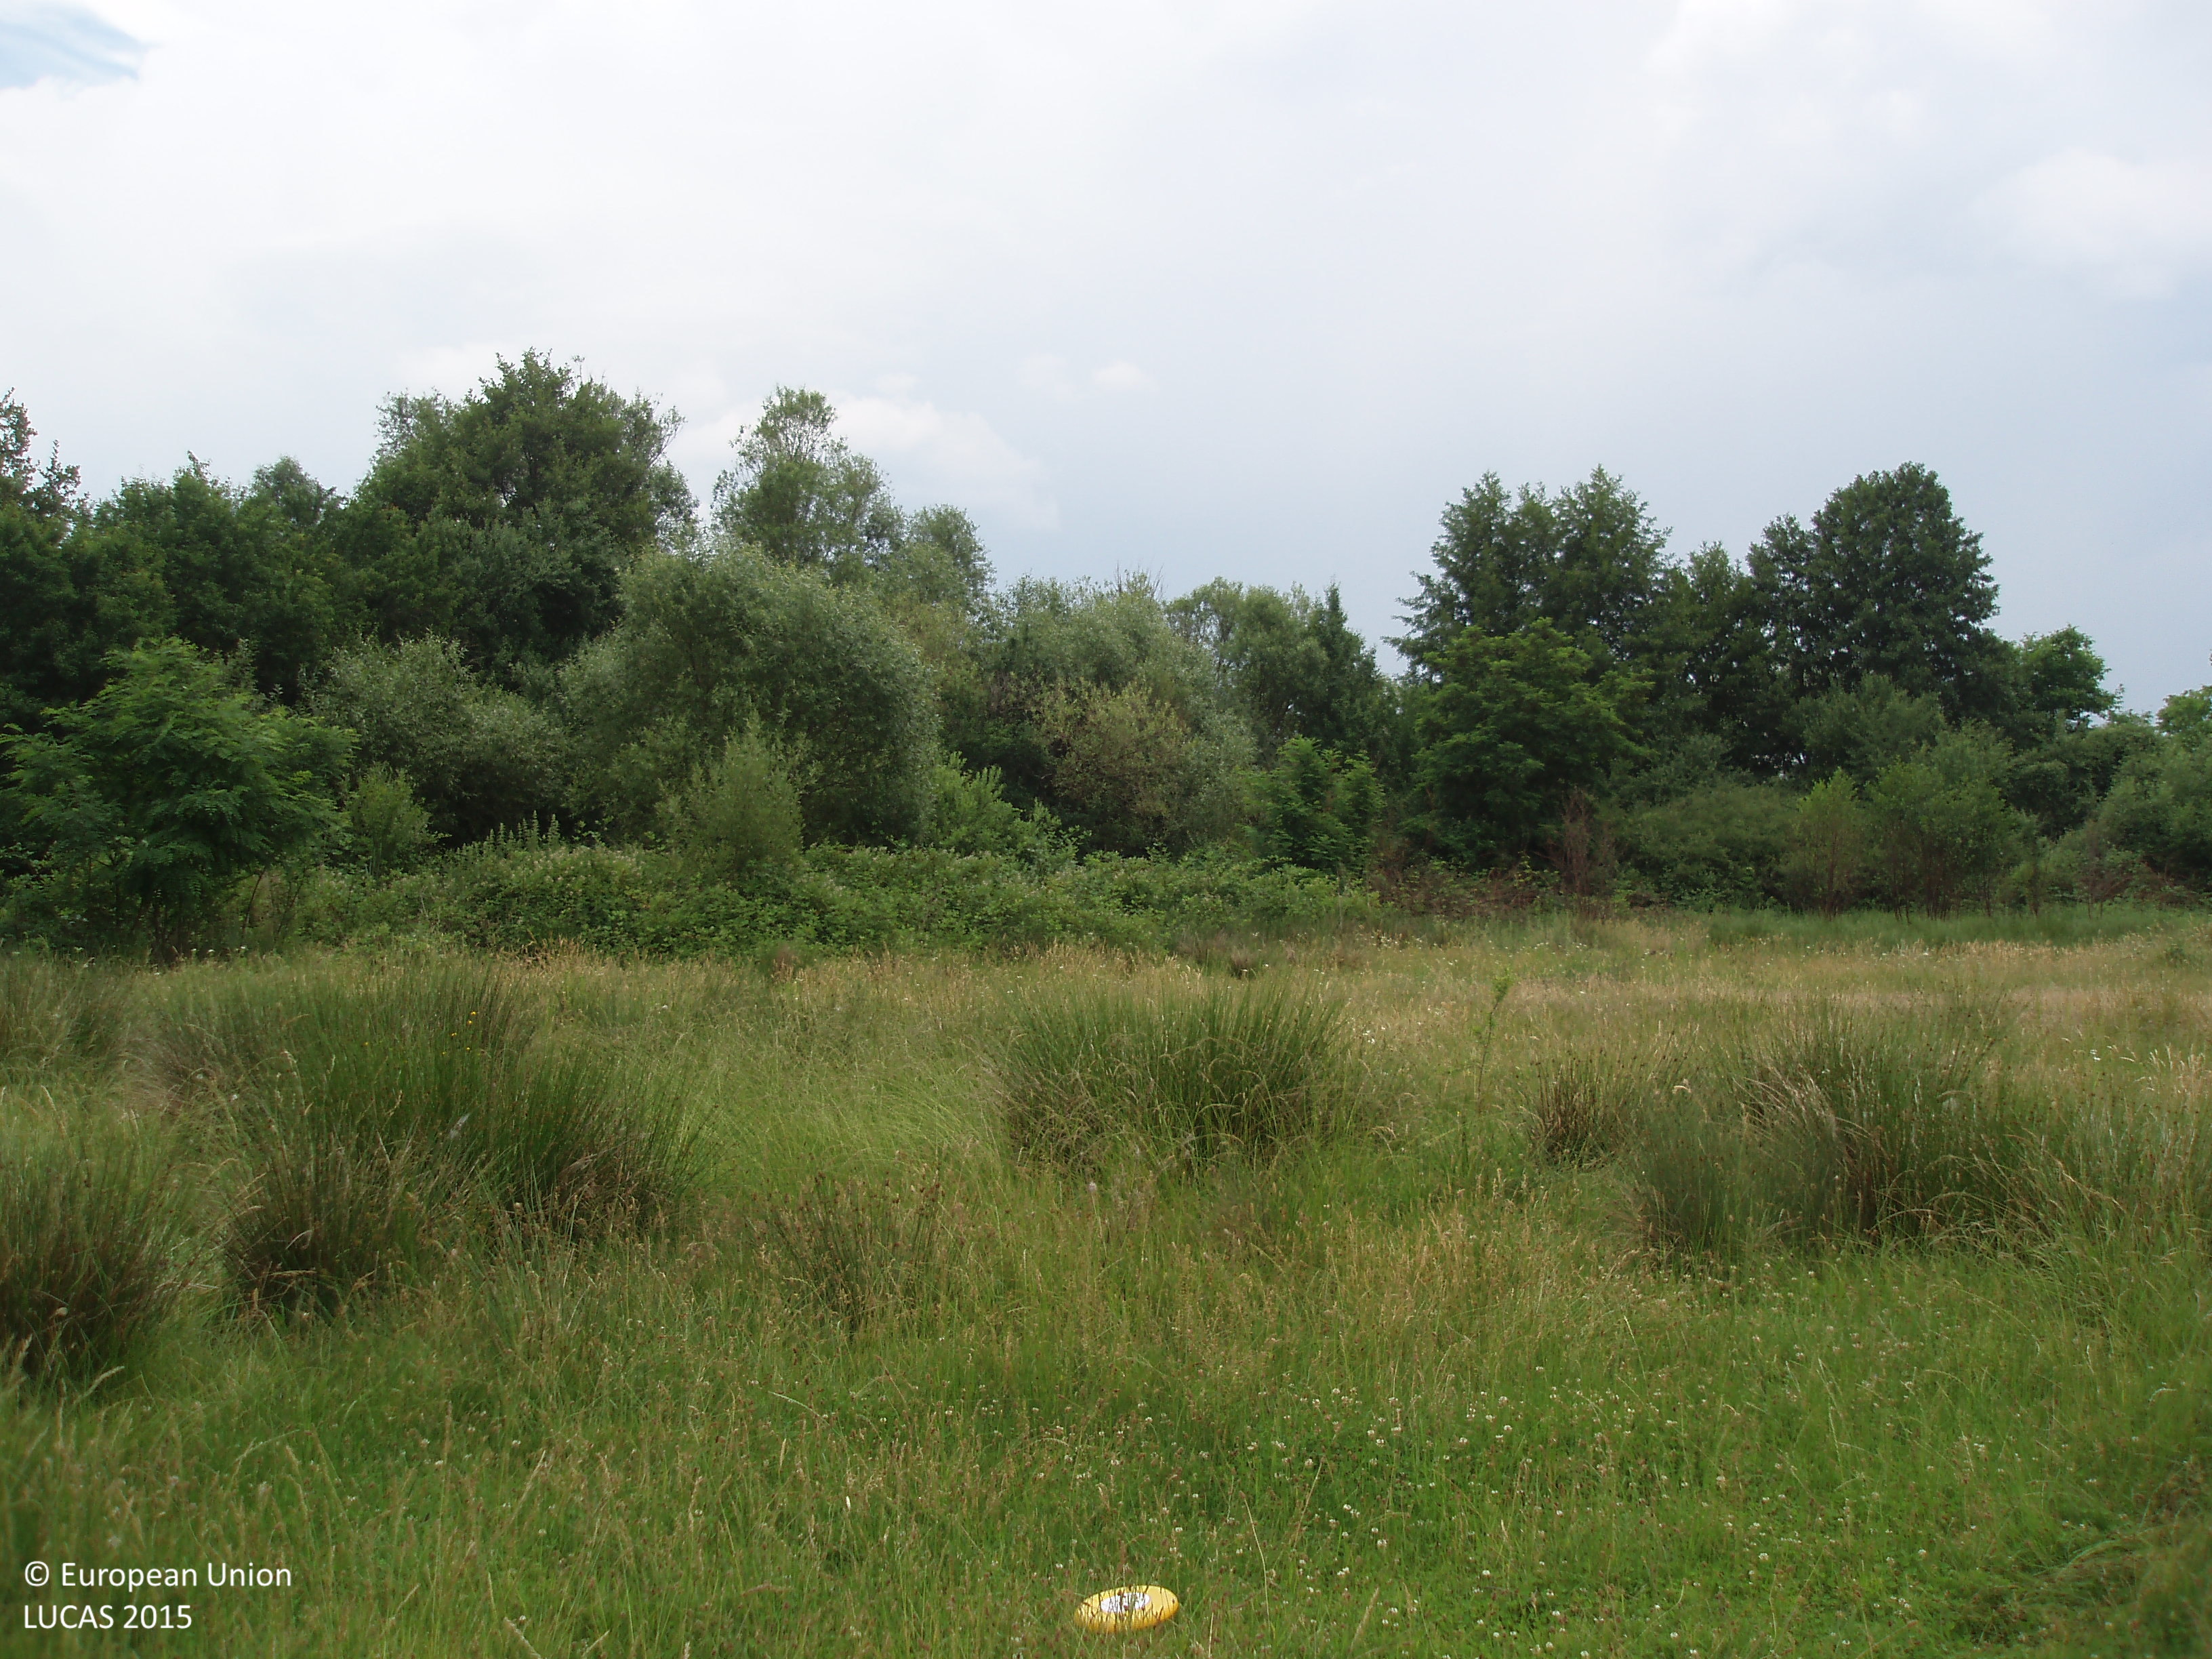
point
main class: Grassland
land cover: Grassland without tree/shrub cover
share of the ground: > 75 %
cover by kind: herbaceous plants 100 %
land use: Agriculture (excluding fallow land and kitchen gardens)
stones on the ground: 10 - 25 %
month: June
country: BG
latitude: 41.6202
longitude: 23.7469
